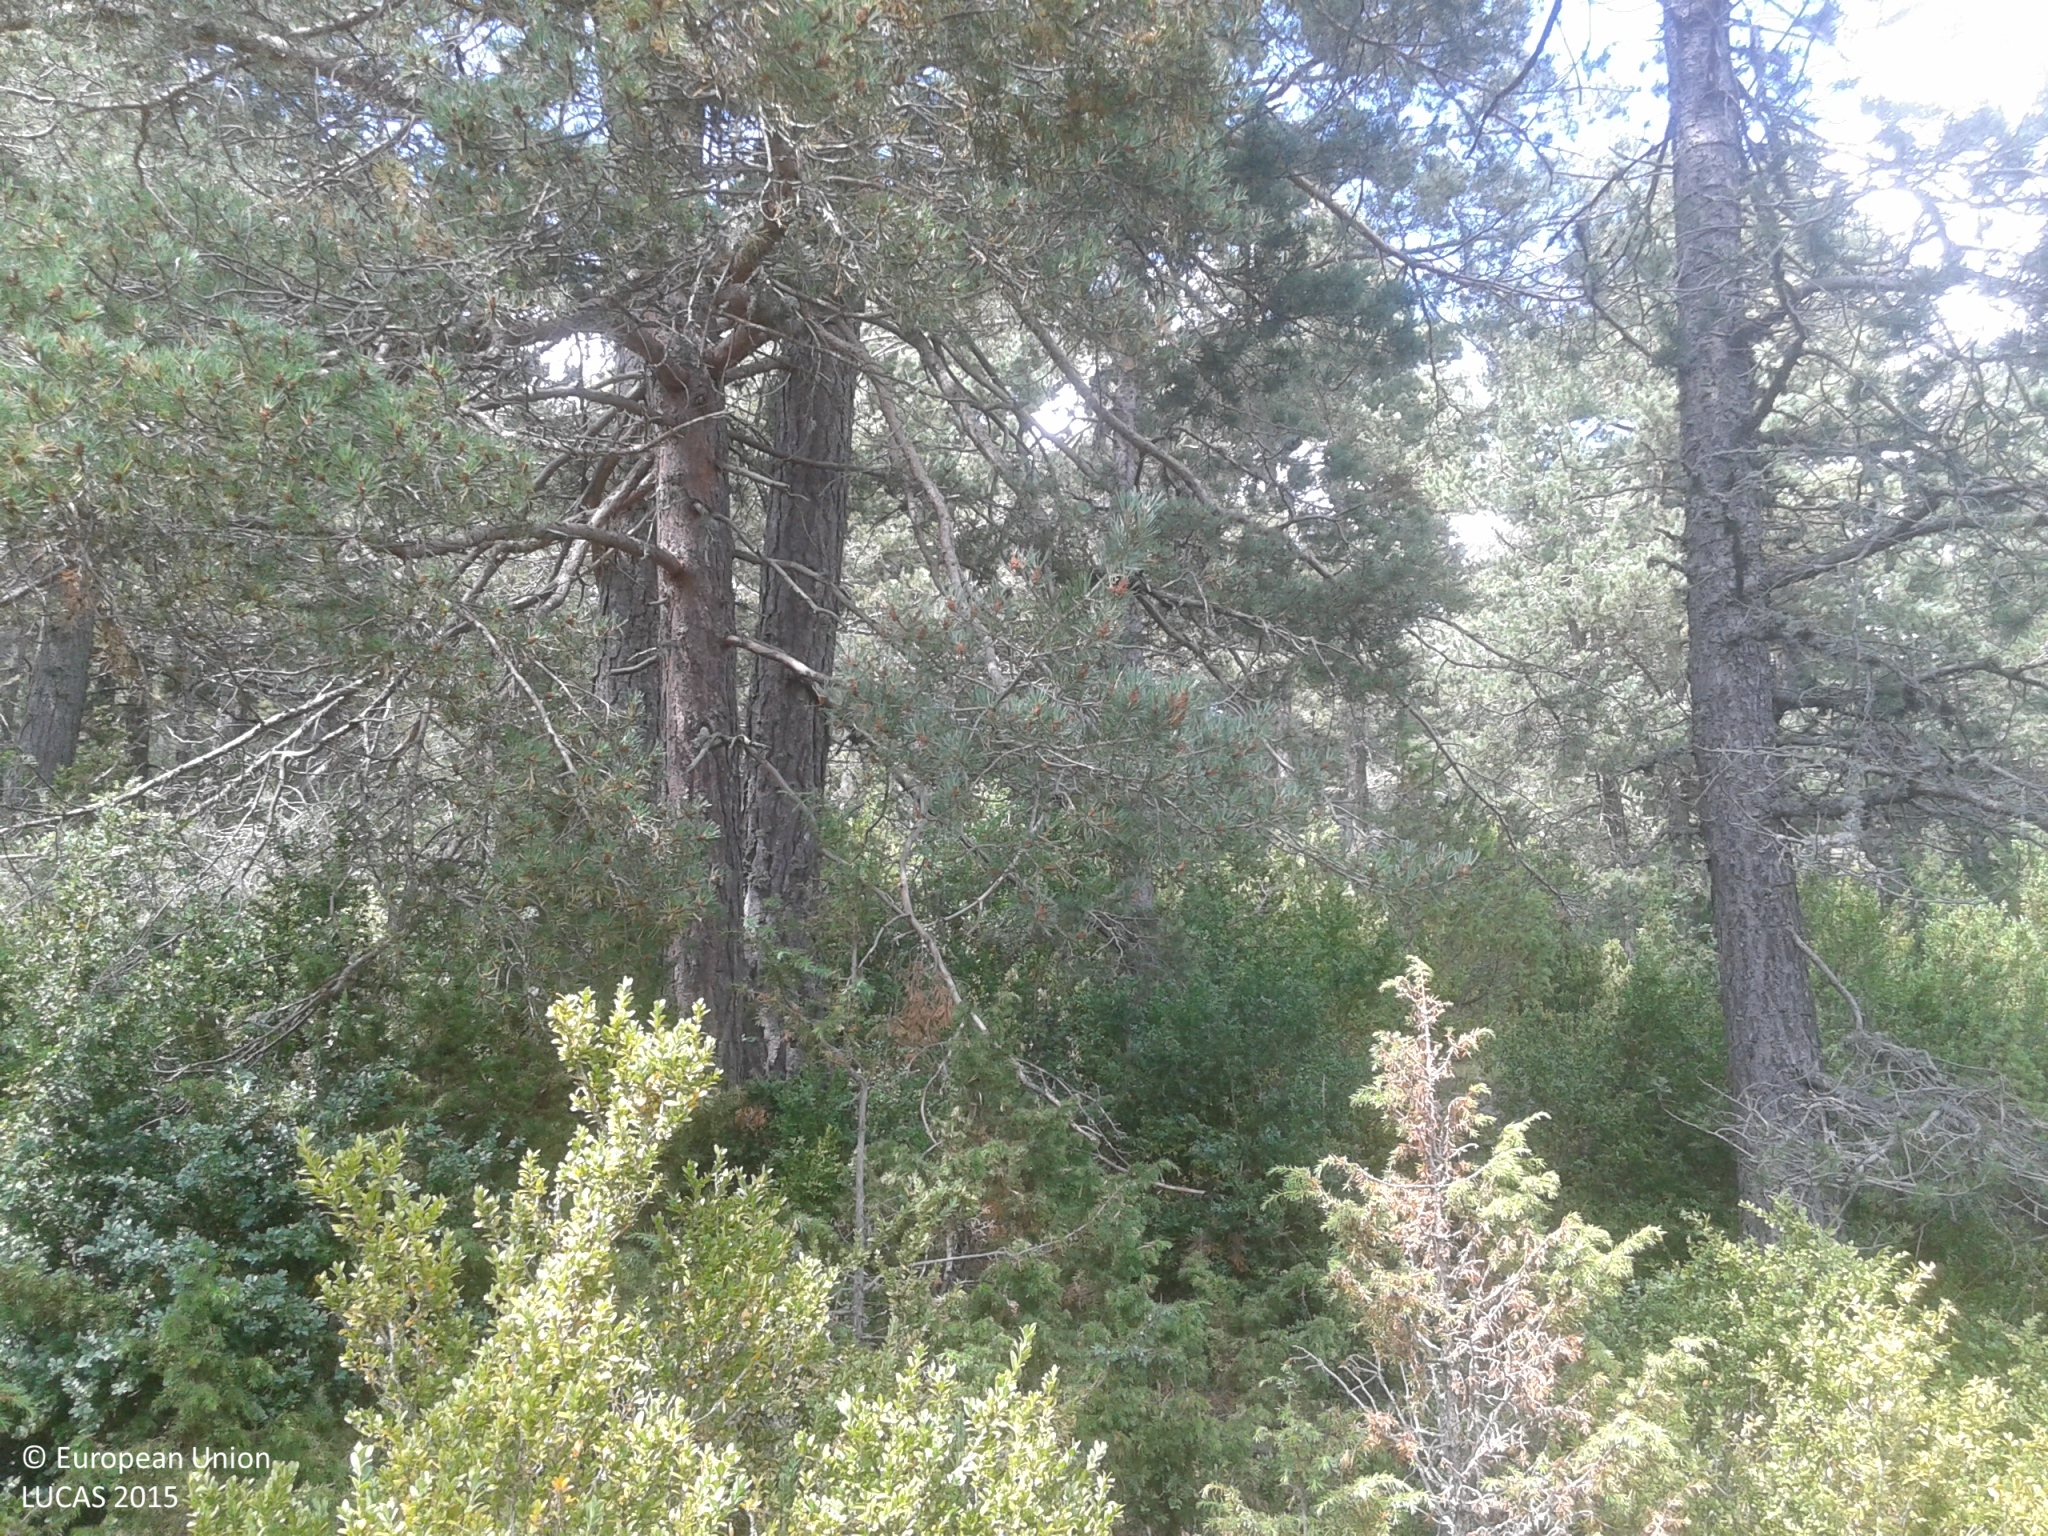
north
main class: Woodland
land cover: Pine dominated coniferous woodland
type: alpine coniferous forest
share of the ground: 25 - 50 %
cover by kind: shrubs 40 %, coniferous forest trees 30 %, herbaceous plants 30 %
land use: Semi-natural and natural areas not in use
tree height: > 5 m
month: July
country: ES
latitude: 42.2312
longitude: 1.5901
